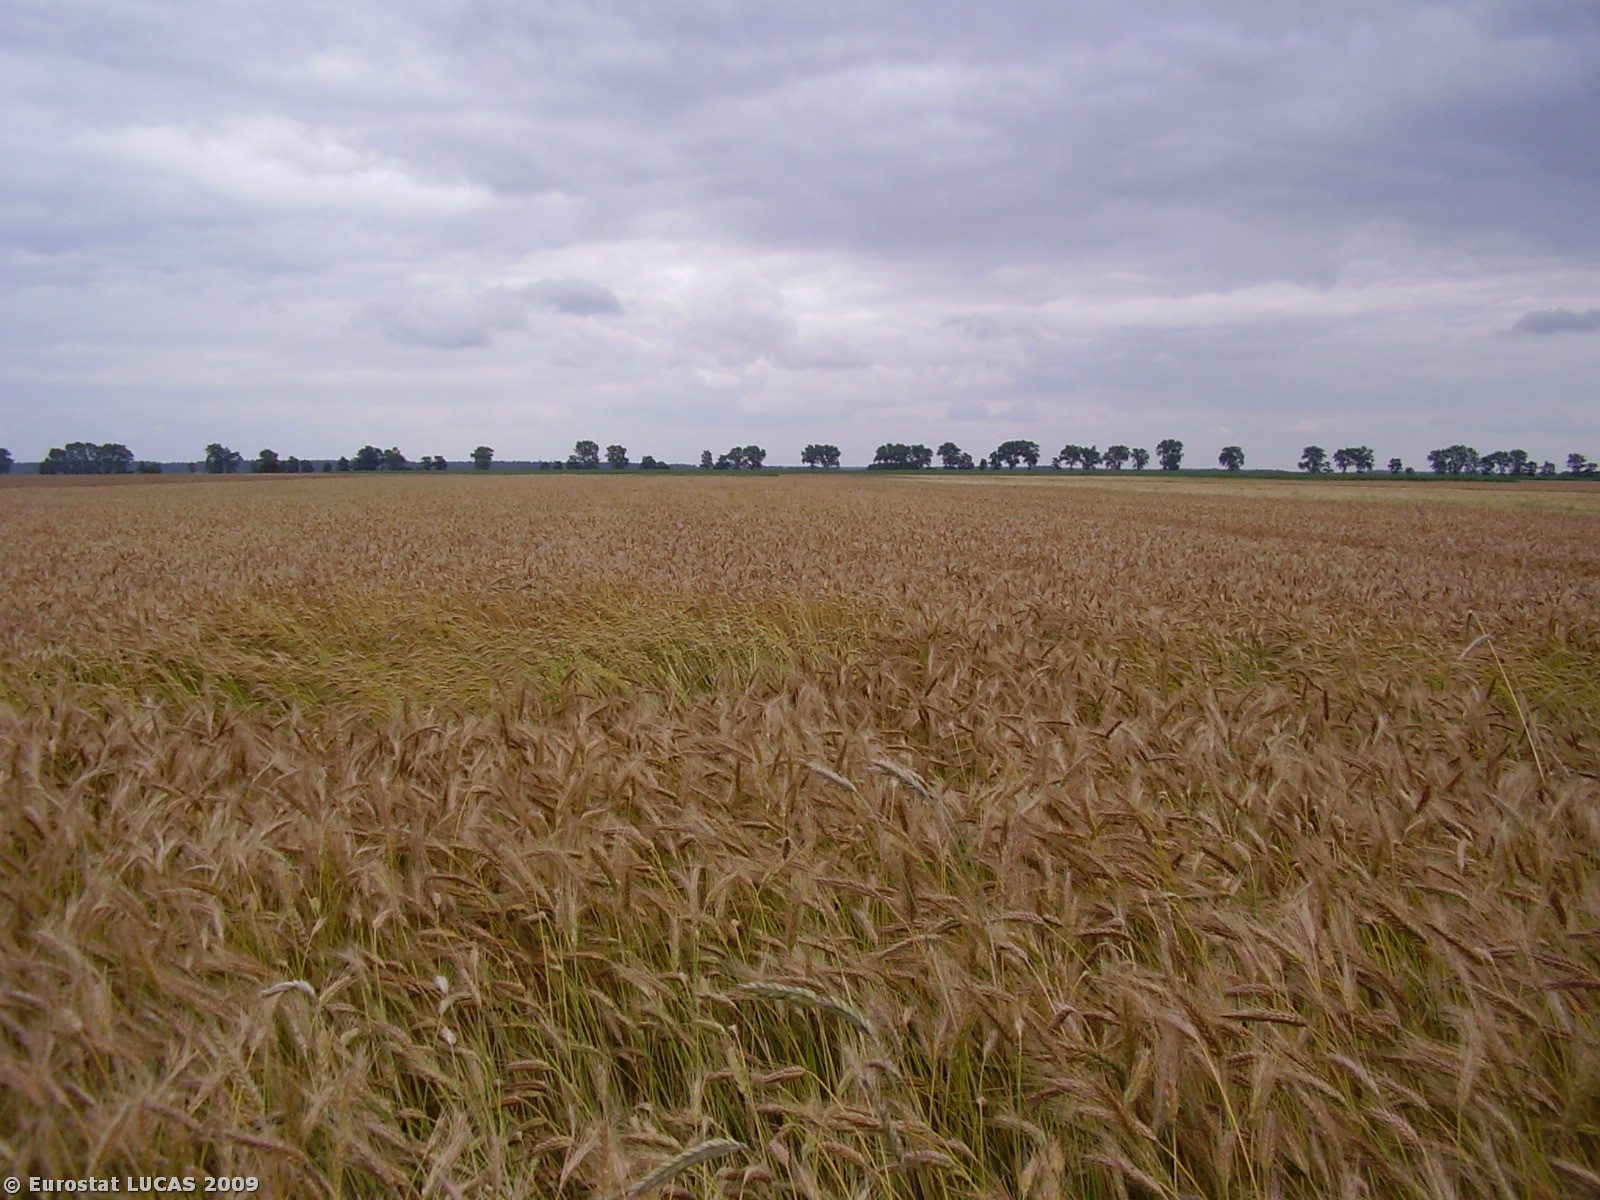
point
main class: Cropland
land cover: Triticale
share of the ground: > 75 %
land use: Agriculture (excluding fallow land and kitchen gardens)
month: July
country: PL
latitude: 51.2259
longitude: 17.6748
